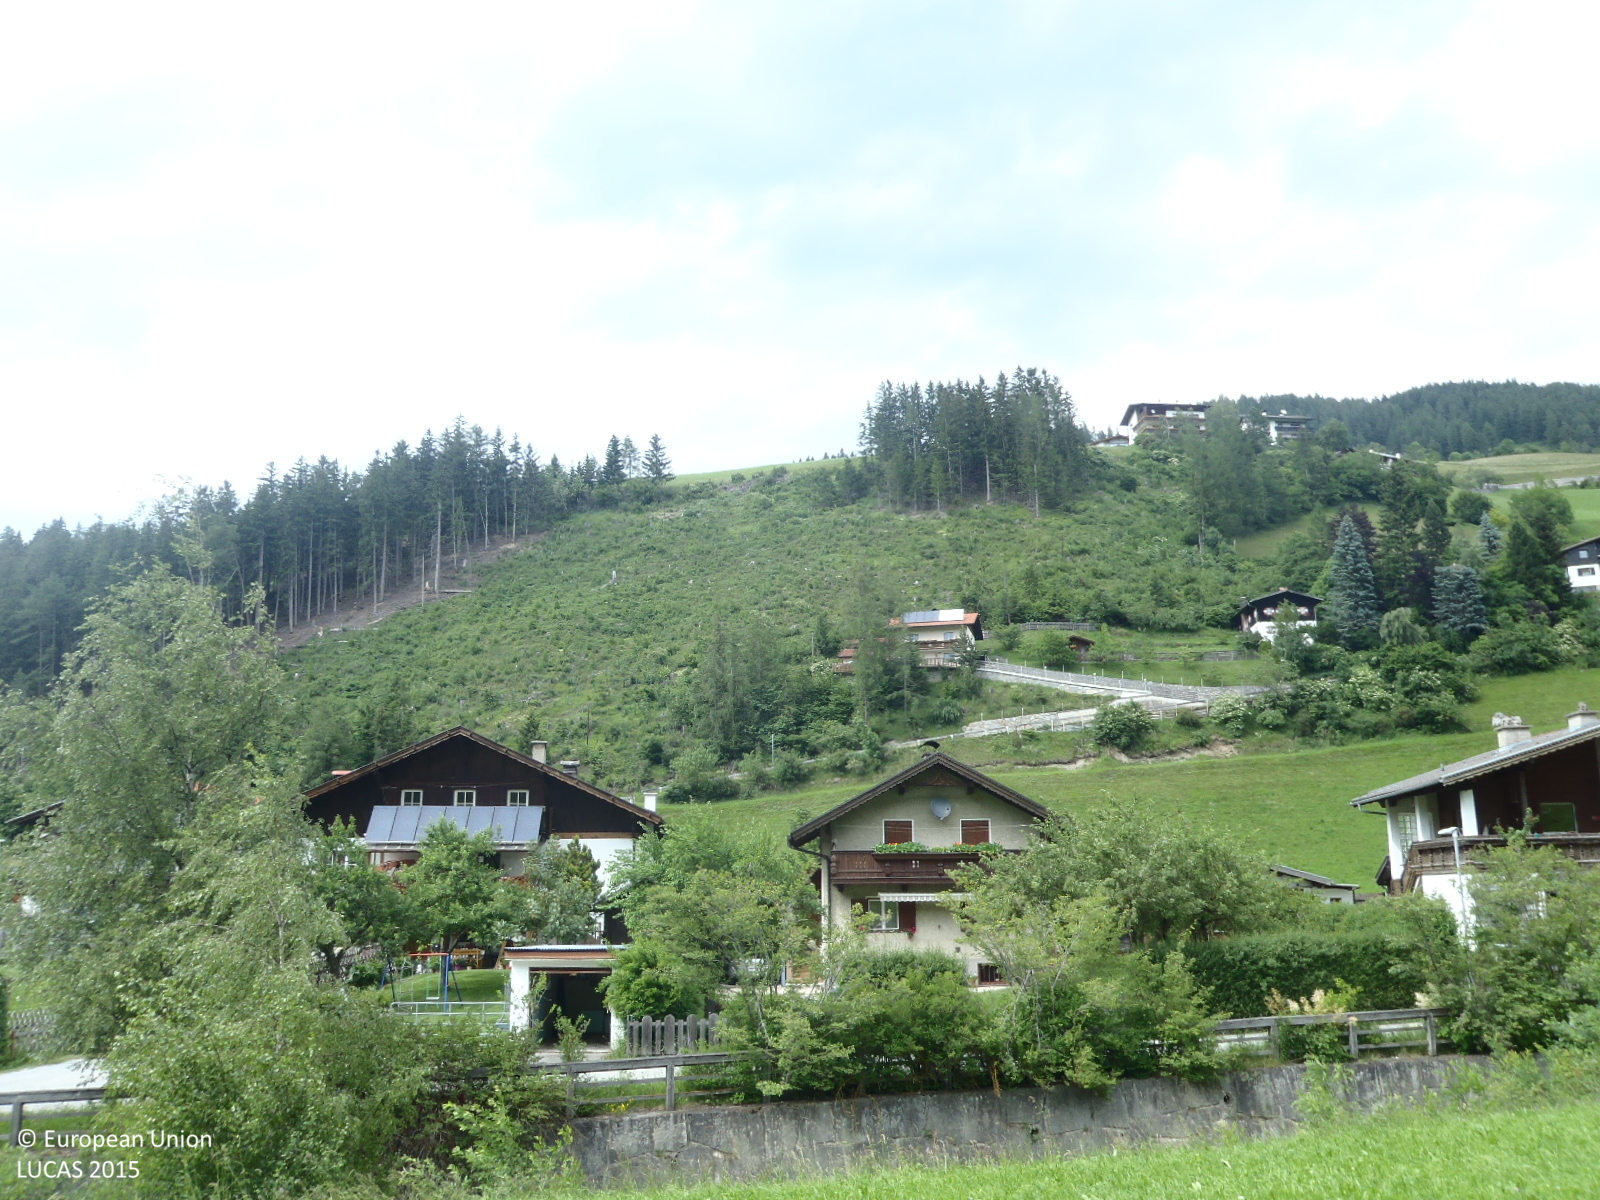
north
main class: Grassland
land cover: Grassland without tree/shrub cover
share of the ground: > 75 %
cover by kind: herbaceous plants 100 %
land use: Agriculture (excluding fallow land and kitchen gardens)
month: June
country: AT
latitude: 47.1157
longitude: 11.4615
